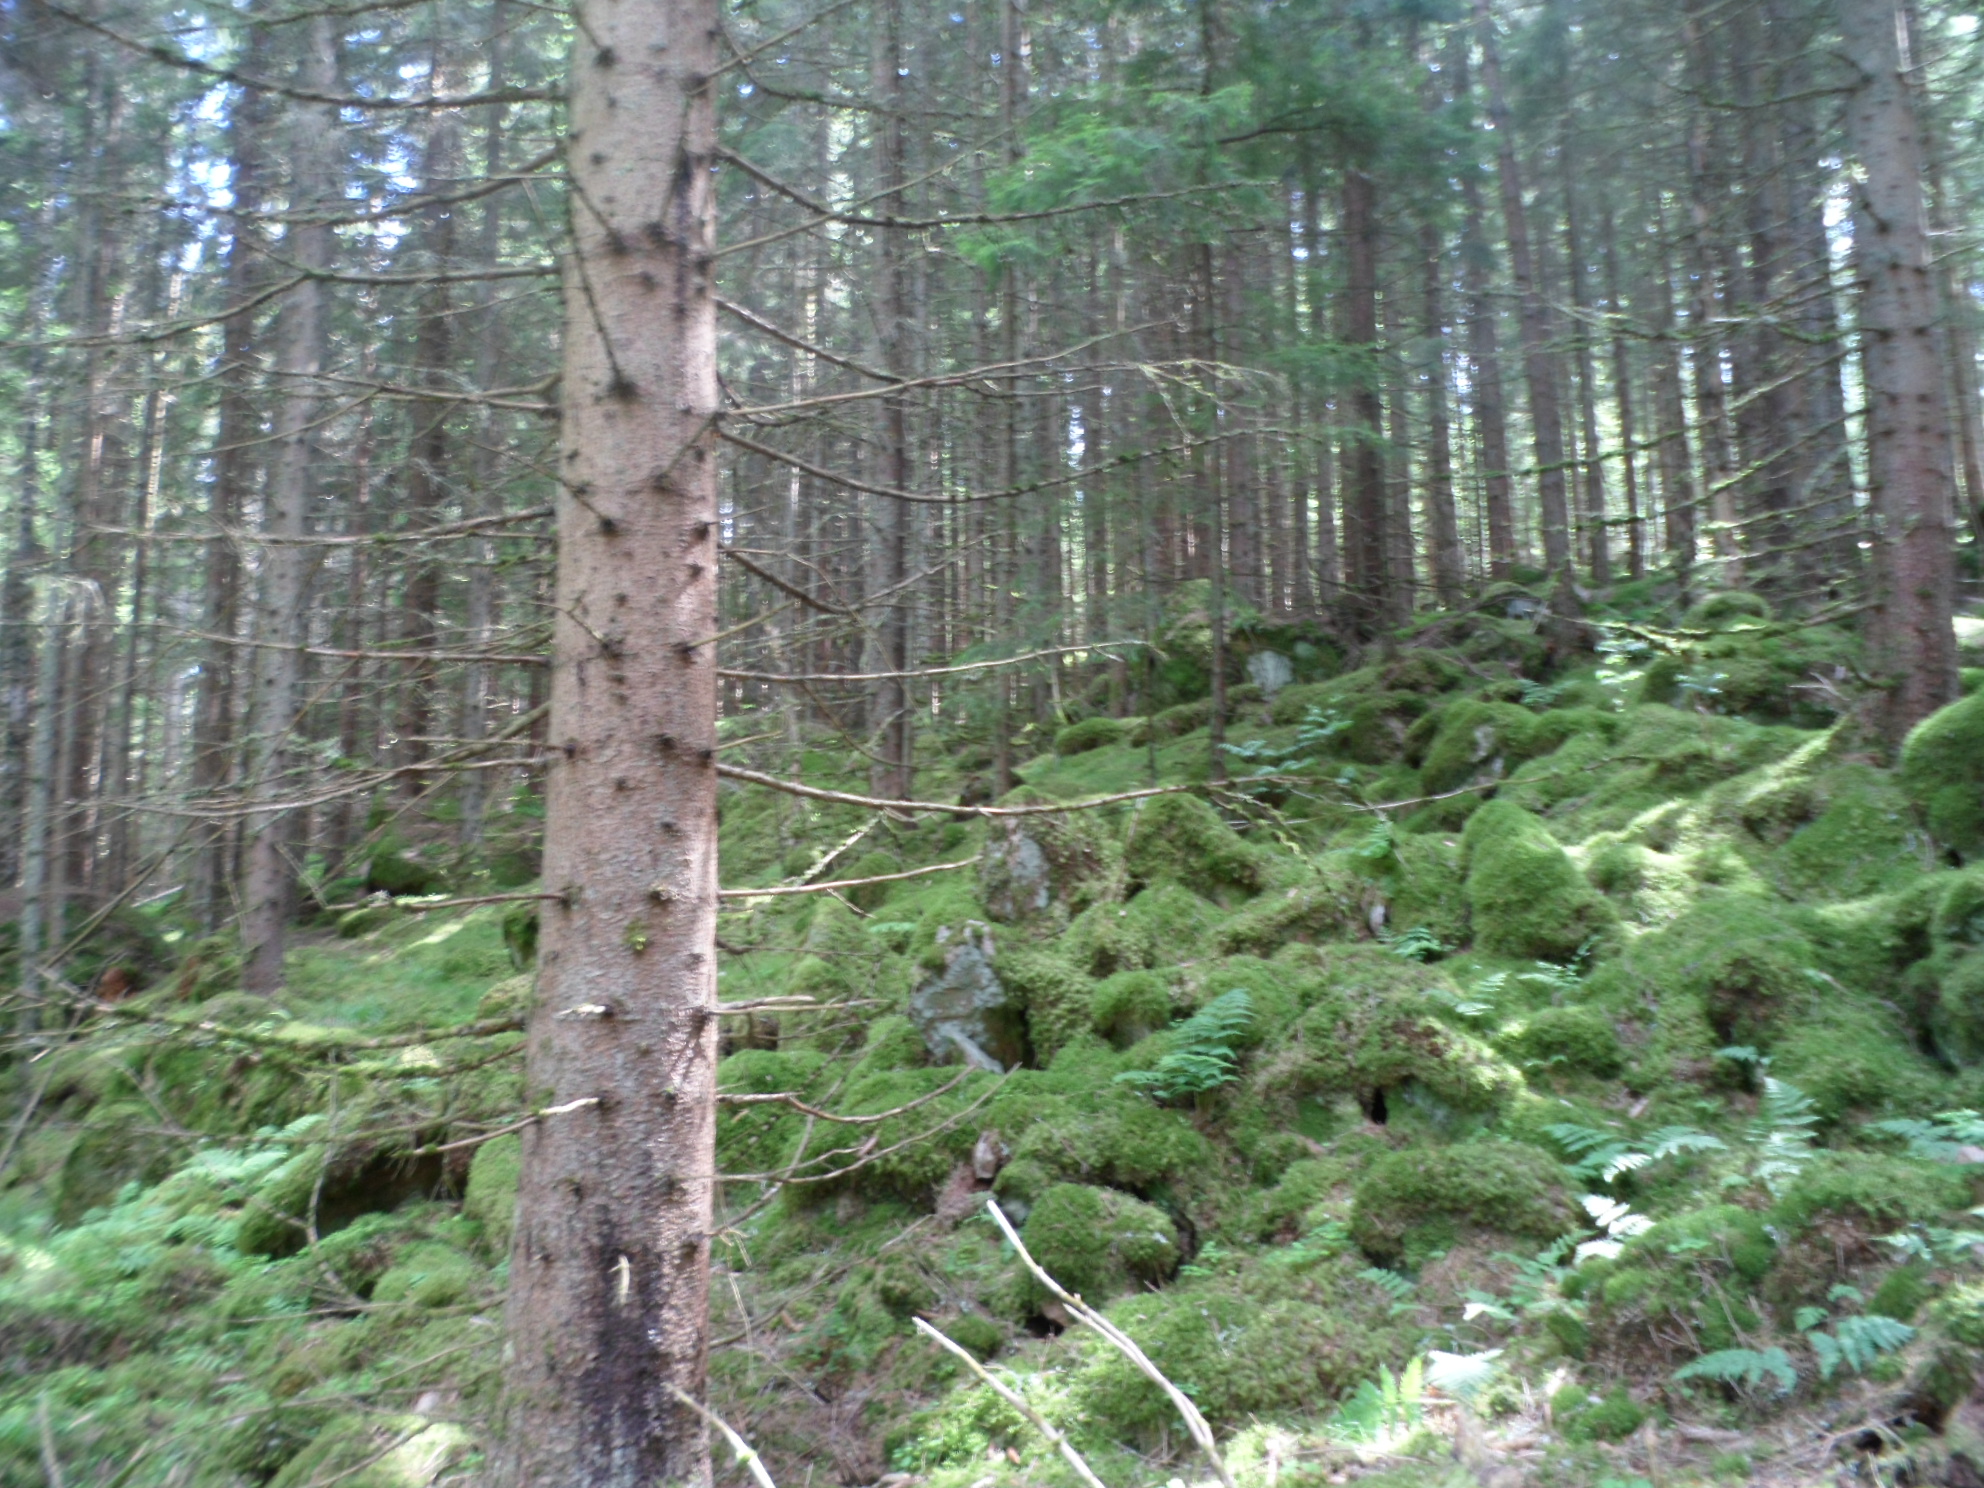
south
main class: Woodland
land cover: Spruce dominated coniferous woodland
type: boreal forest
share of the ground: > 75 %
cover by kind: coniferous forest trees 75 %, lichens and mosses 15 %, shrubs 5 %, herbaceous plants 5 %
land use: Forestry
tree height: > 5 m
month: June
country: SE
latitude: 57.1438
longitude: 14.7728
